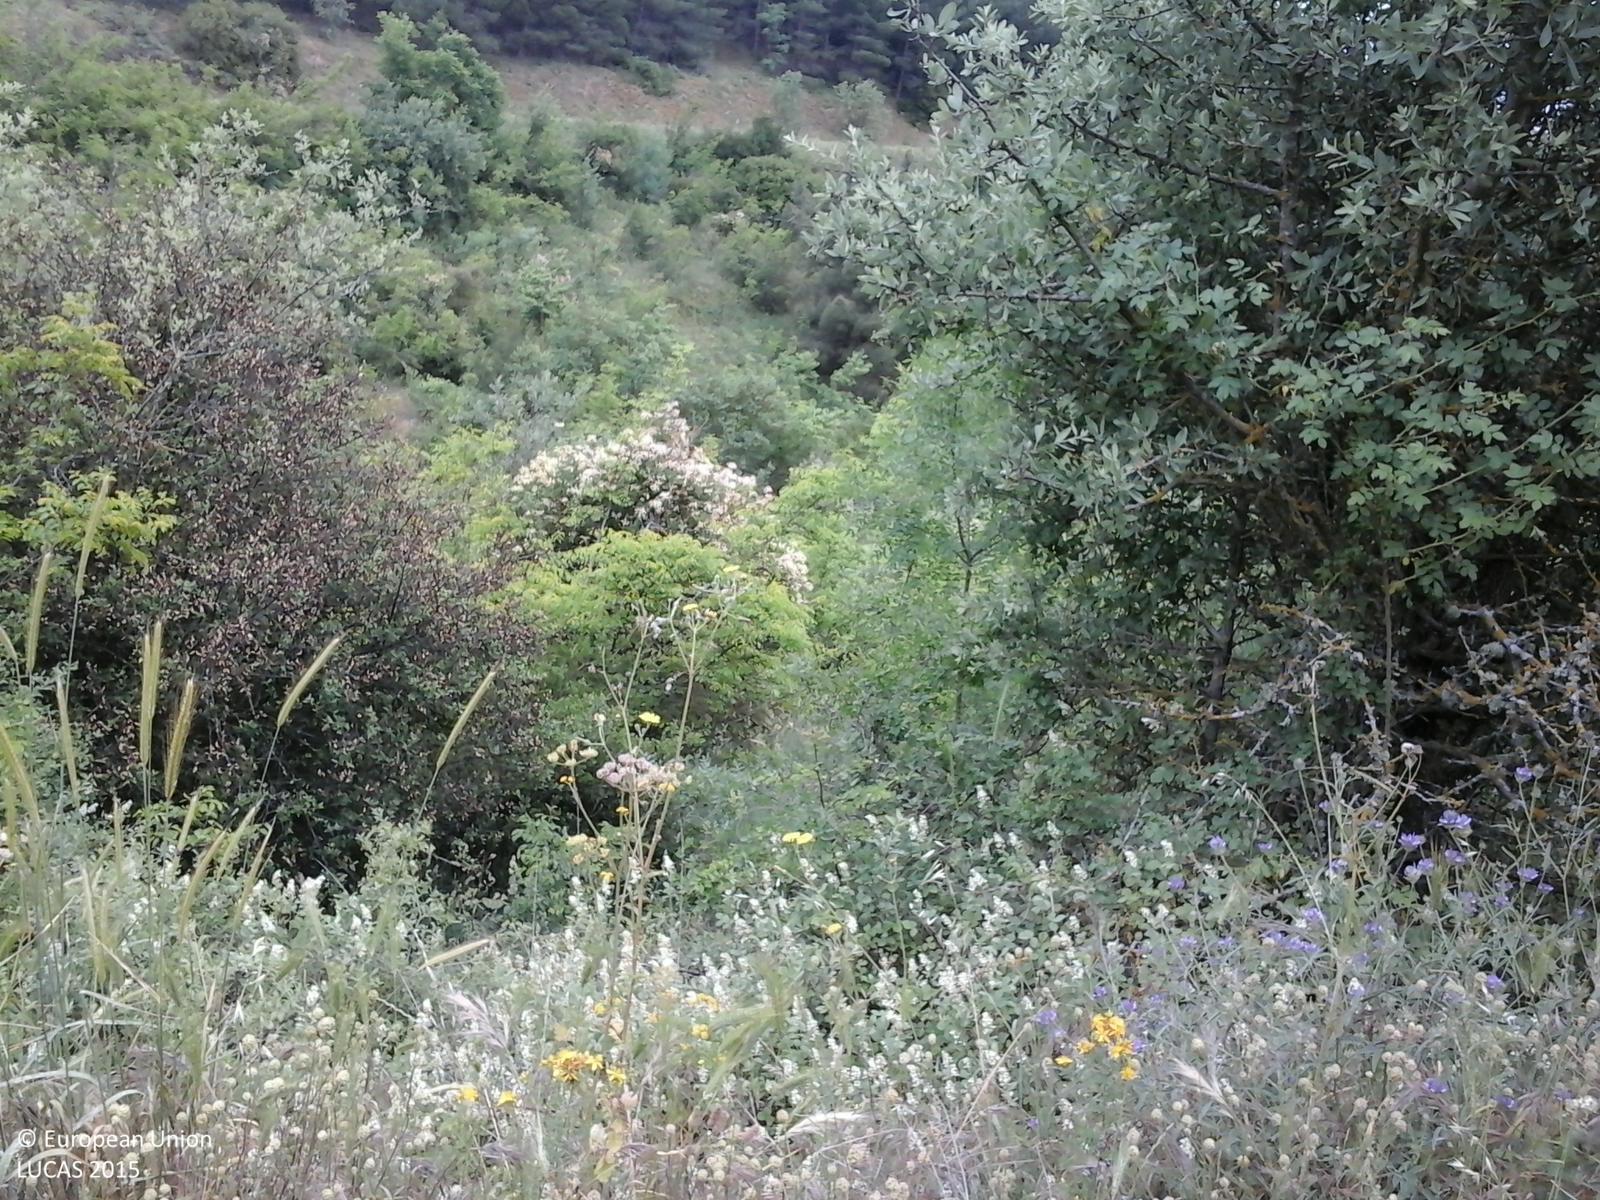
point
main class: Shrubland
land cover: Shrubland without tree cover
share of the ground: > 75 %
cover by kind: shrubs 95 %, herbaceous plants 5 %
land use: Semi-natural and natural areas not in use
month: May
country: GR
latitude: 40.7403
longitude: 22.9519
